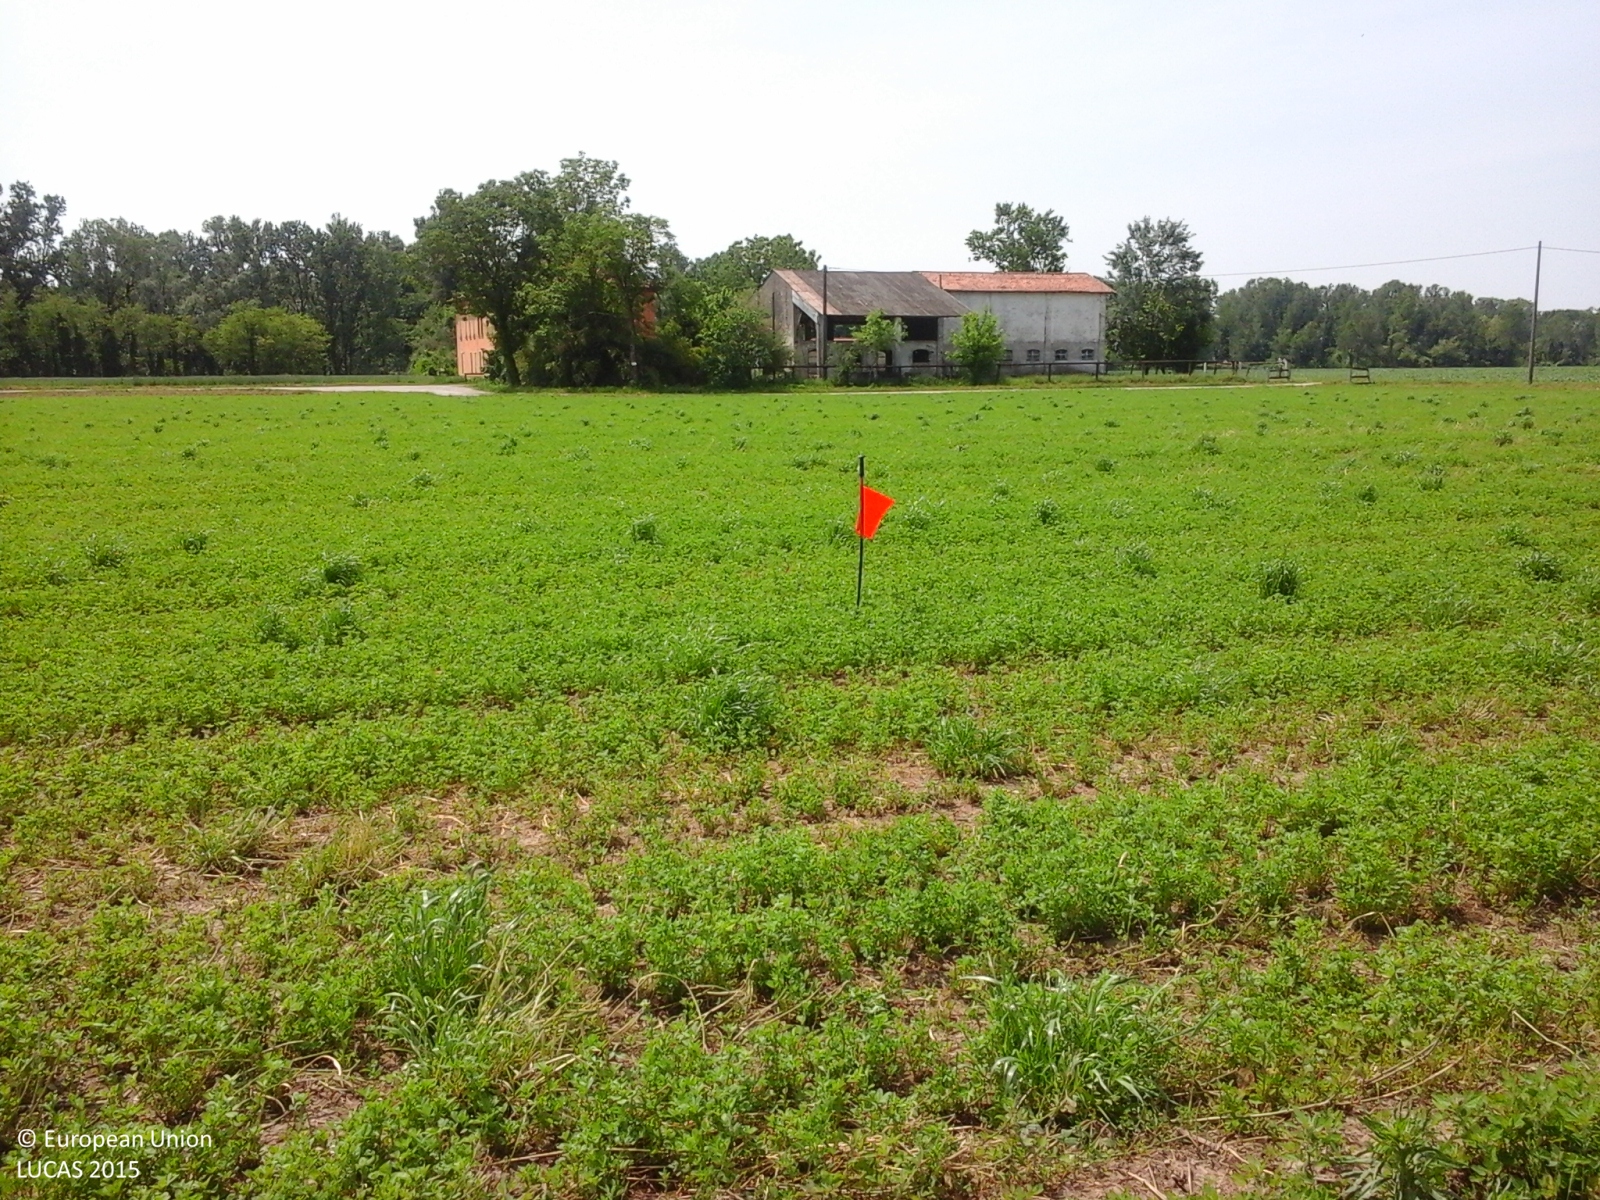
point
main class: Cropland
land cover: Lucerne
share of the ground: > 75 %
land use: Agriculture (excluding fallow land and kitchen gardens)
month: May
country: IT
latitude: 45.3421
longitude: 9.9108
